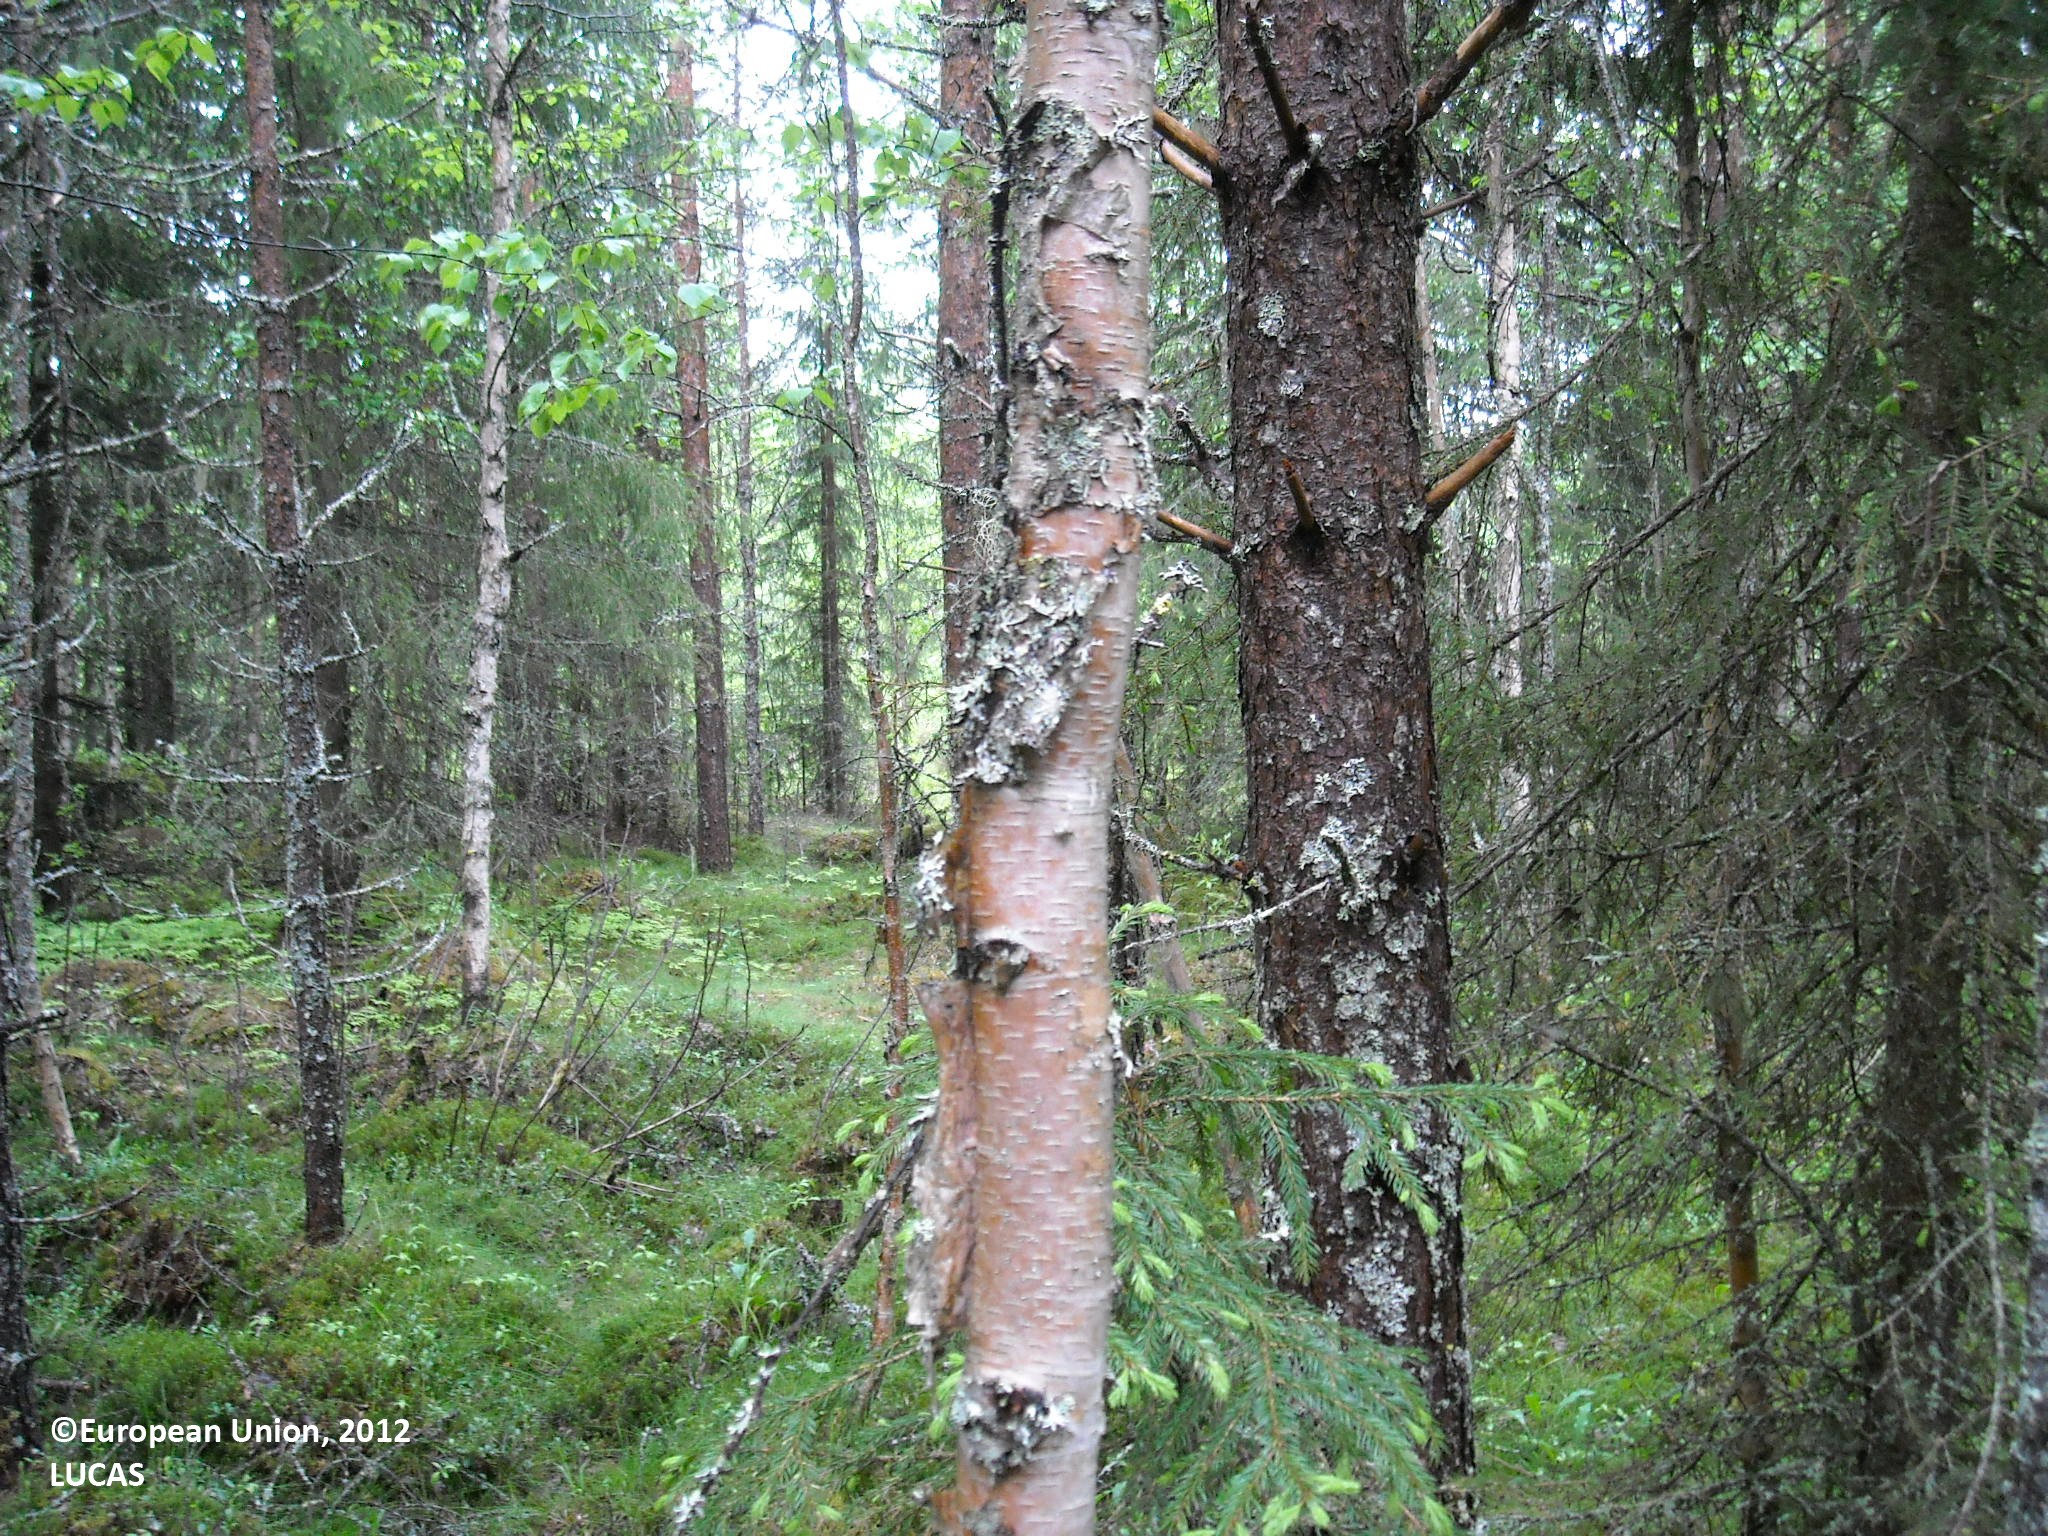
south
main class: Woodland
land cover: Other mixed woodland
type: boreal forest
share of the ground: > 75 %
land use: Forestry
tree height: > 5 m
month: June
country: FI
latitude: 65.4728
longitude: 27.9100
